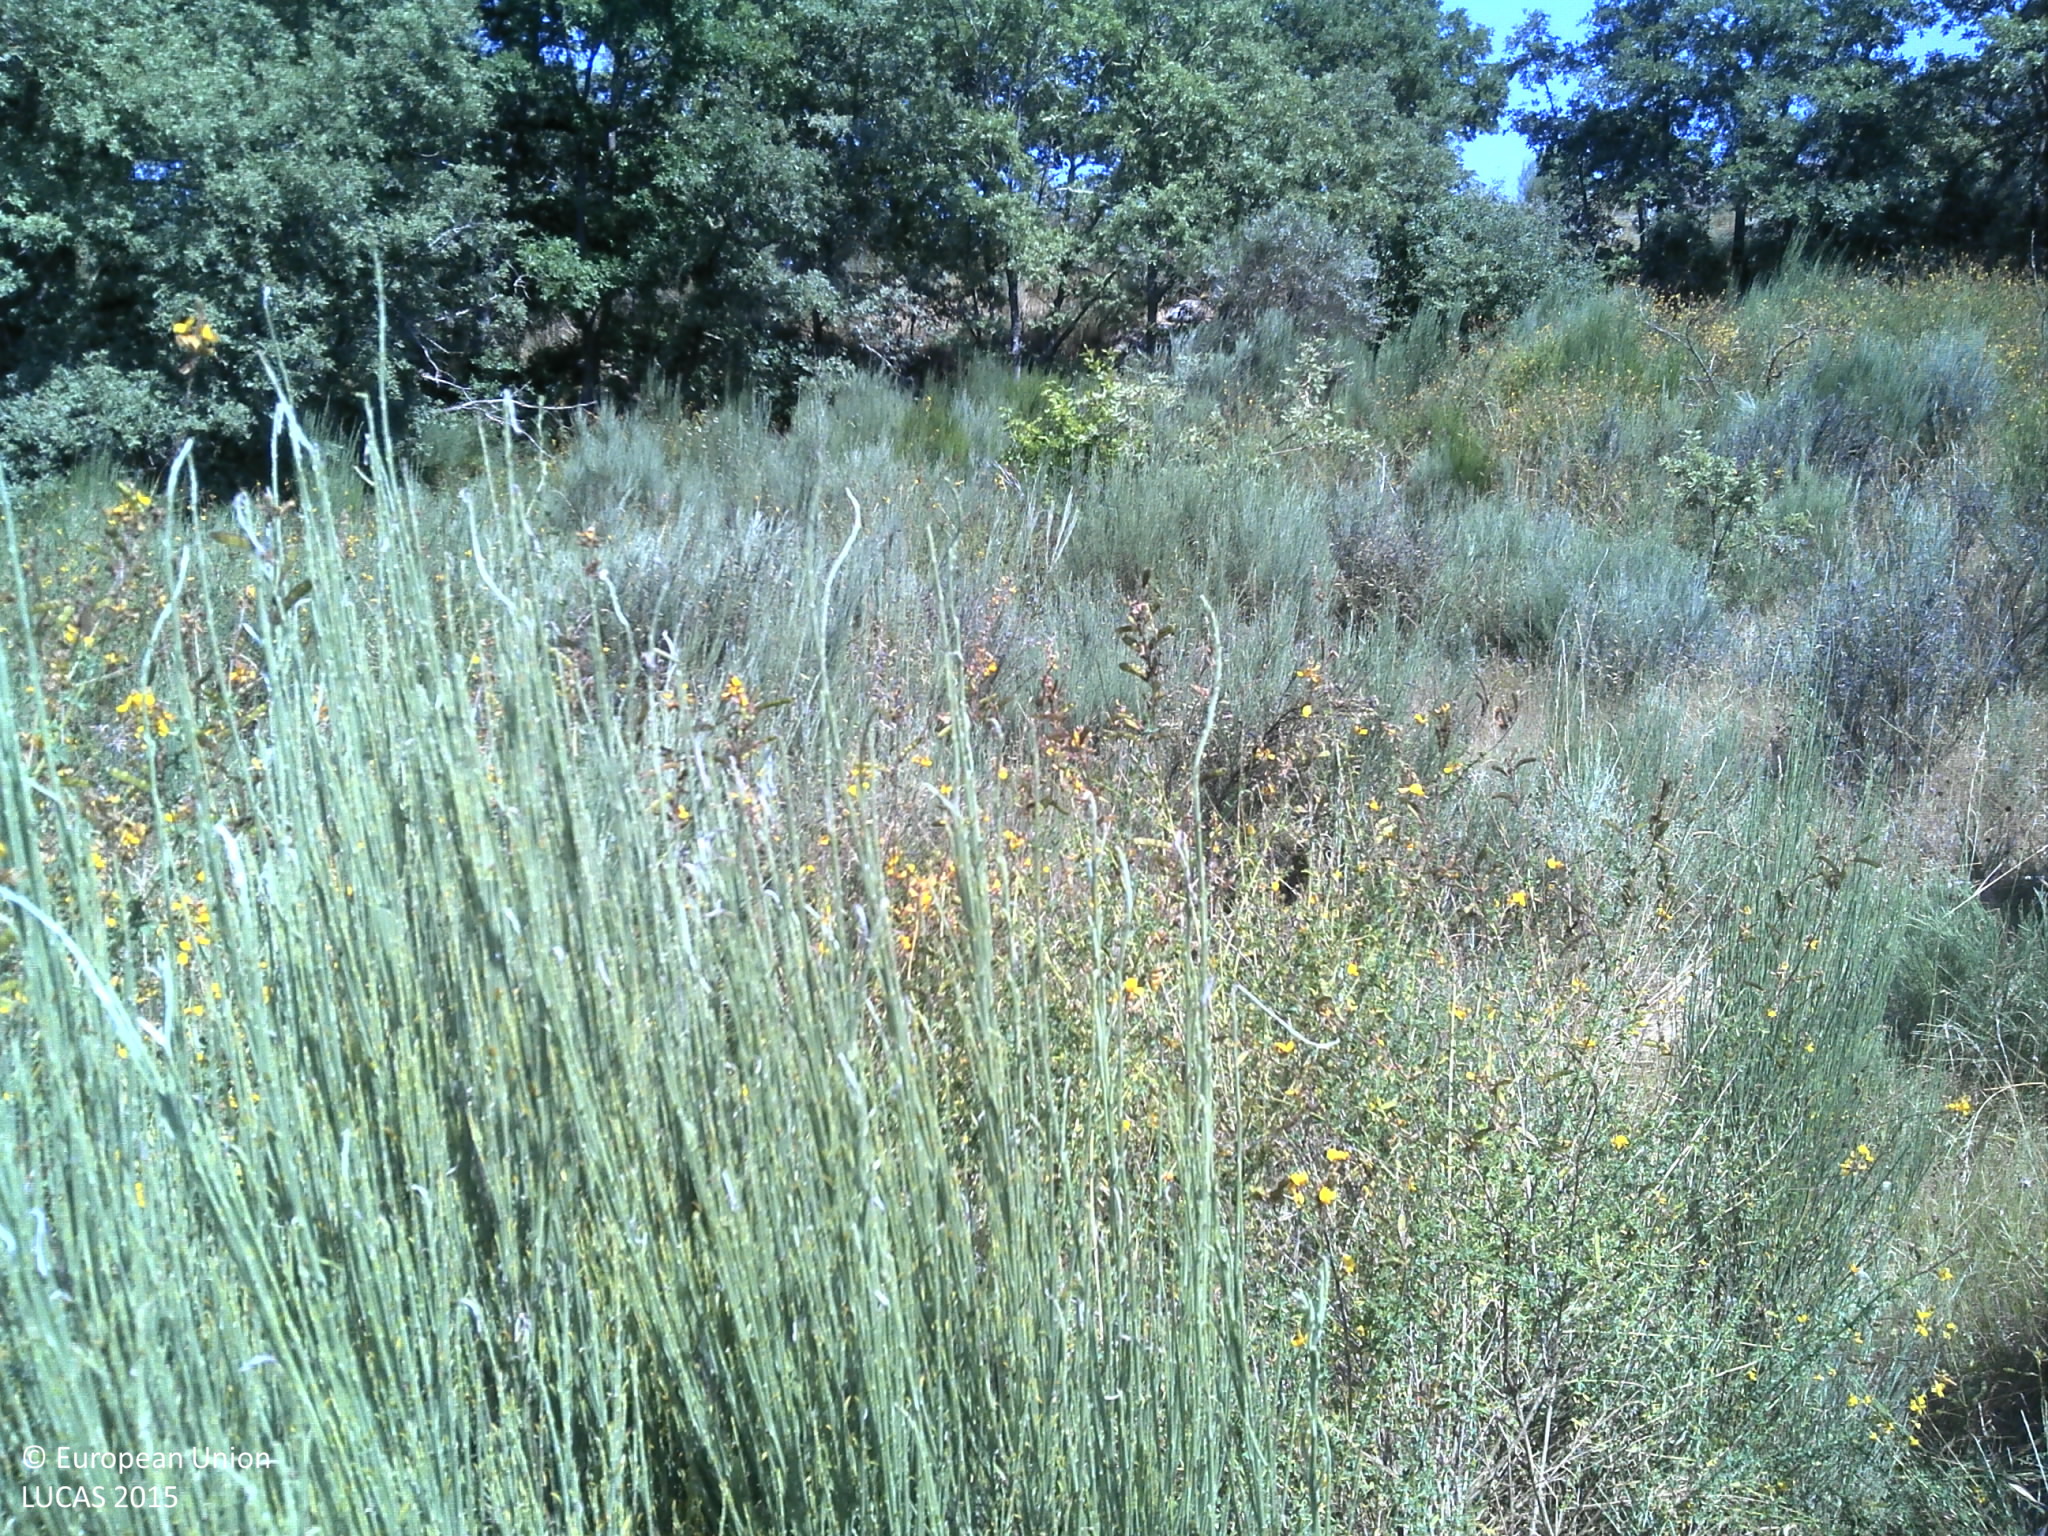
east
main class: Shrubland
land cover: Shrubland without tree cover
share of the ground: > 75 %
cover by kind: shrubs 90 %, herbaceous plants 5 %, unconsolidated bare surface 5 %
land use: Agriculture (excluding fallow land and kitchen gardens)
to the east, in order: Shrubland without tree cover; Dry stone walls; Broadleaved woodland; Dry stone walls; Shrubland with sparse tree cover; Shrubland without tree cover; Shrubland with sparse tree cover
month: July
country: PT
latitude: 41.8101
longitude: -7.8480
